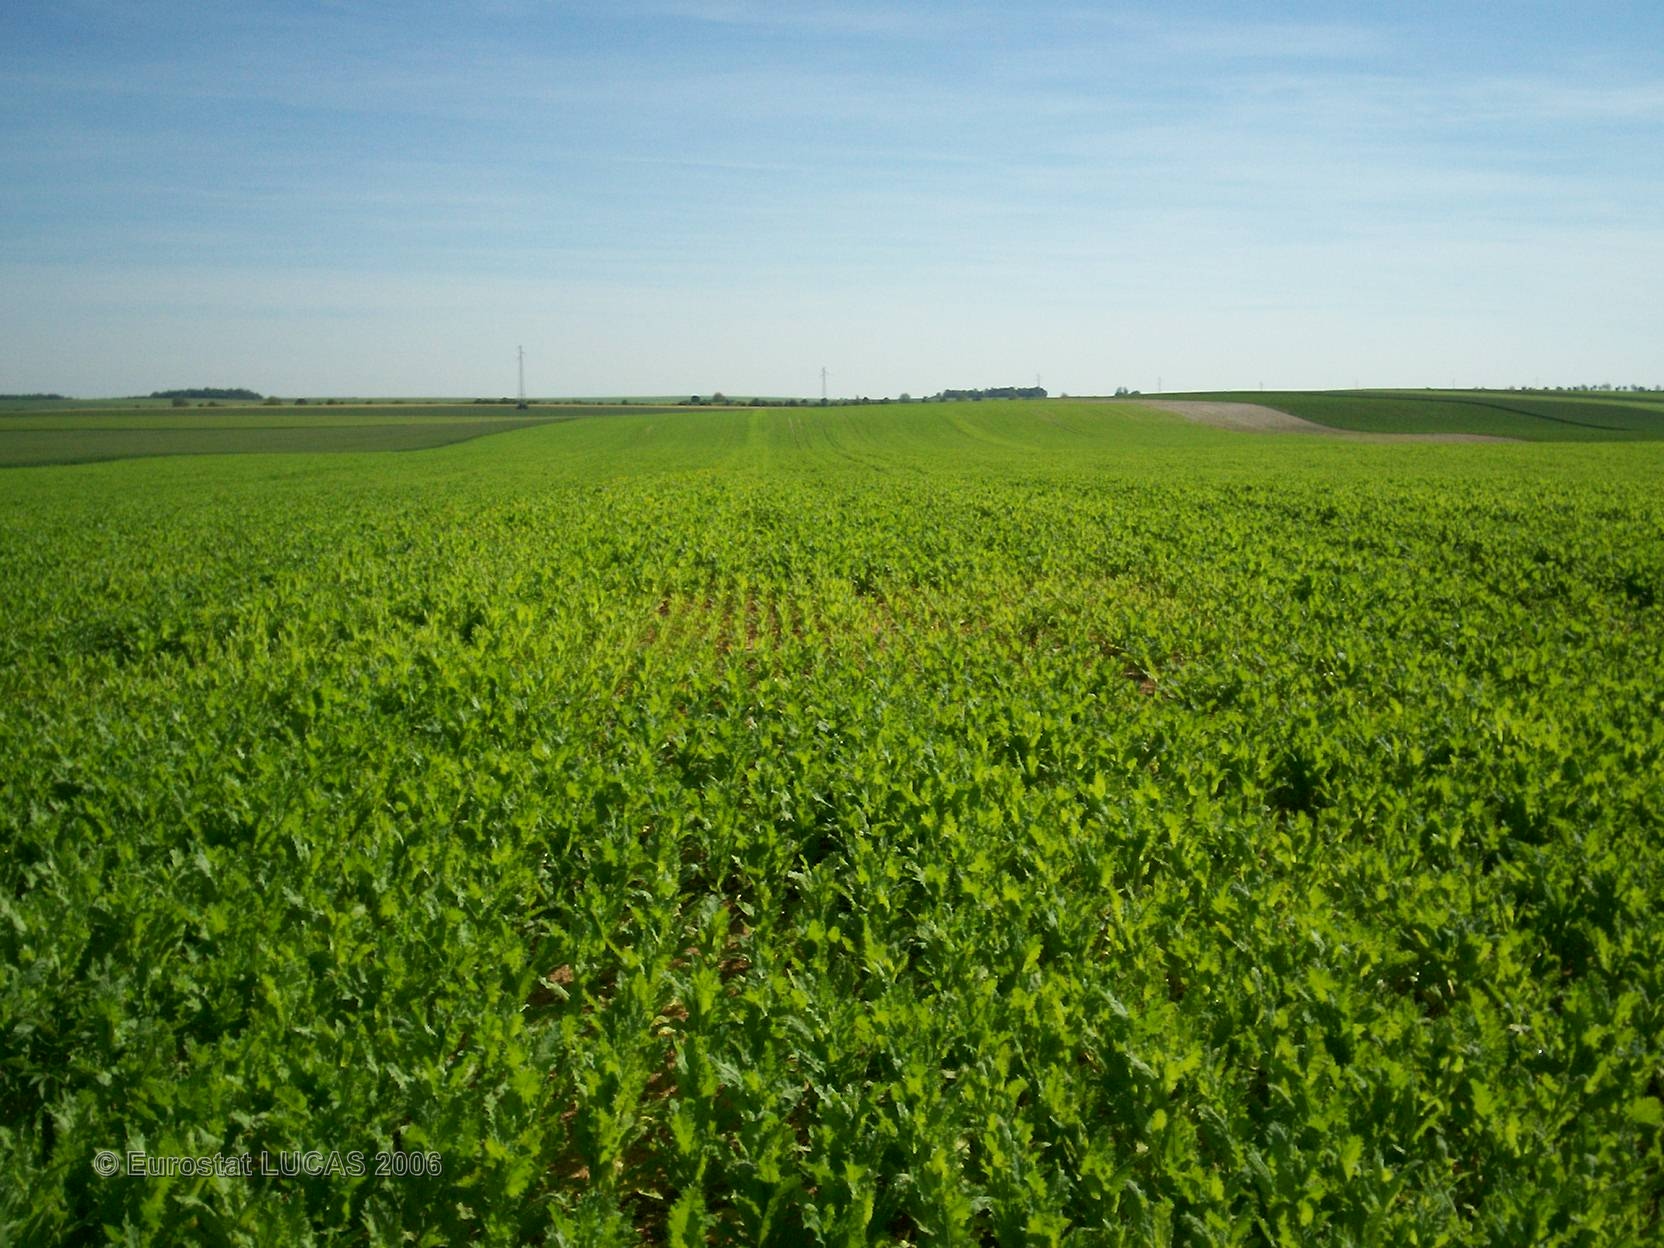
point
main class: Cropland
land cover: Other fibre and oleaginous crops
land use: Agriculture (excluding fallow land and kitchen gardens)
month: June
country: FR
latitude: 49.1017
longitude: 4.6140
